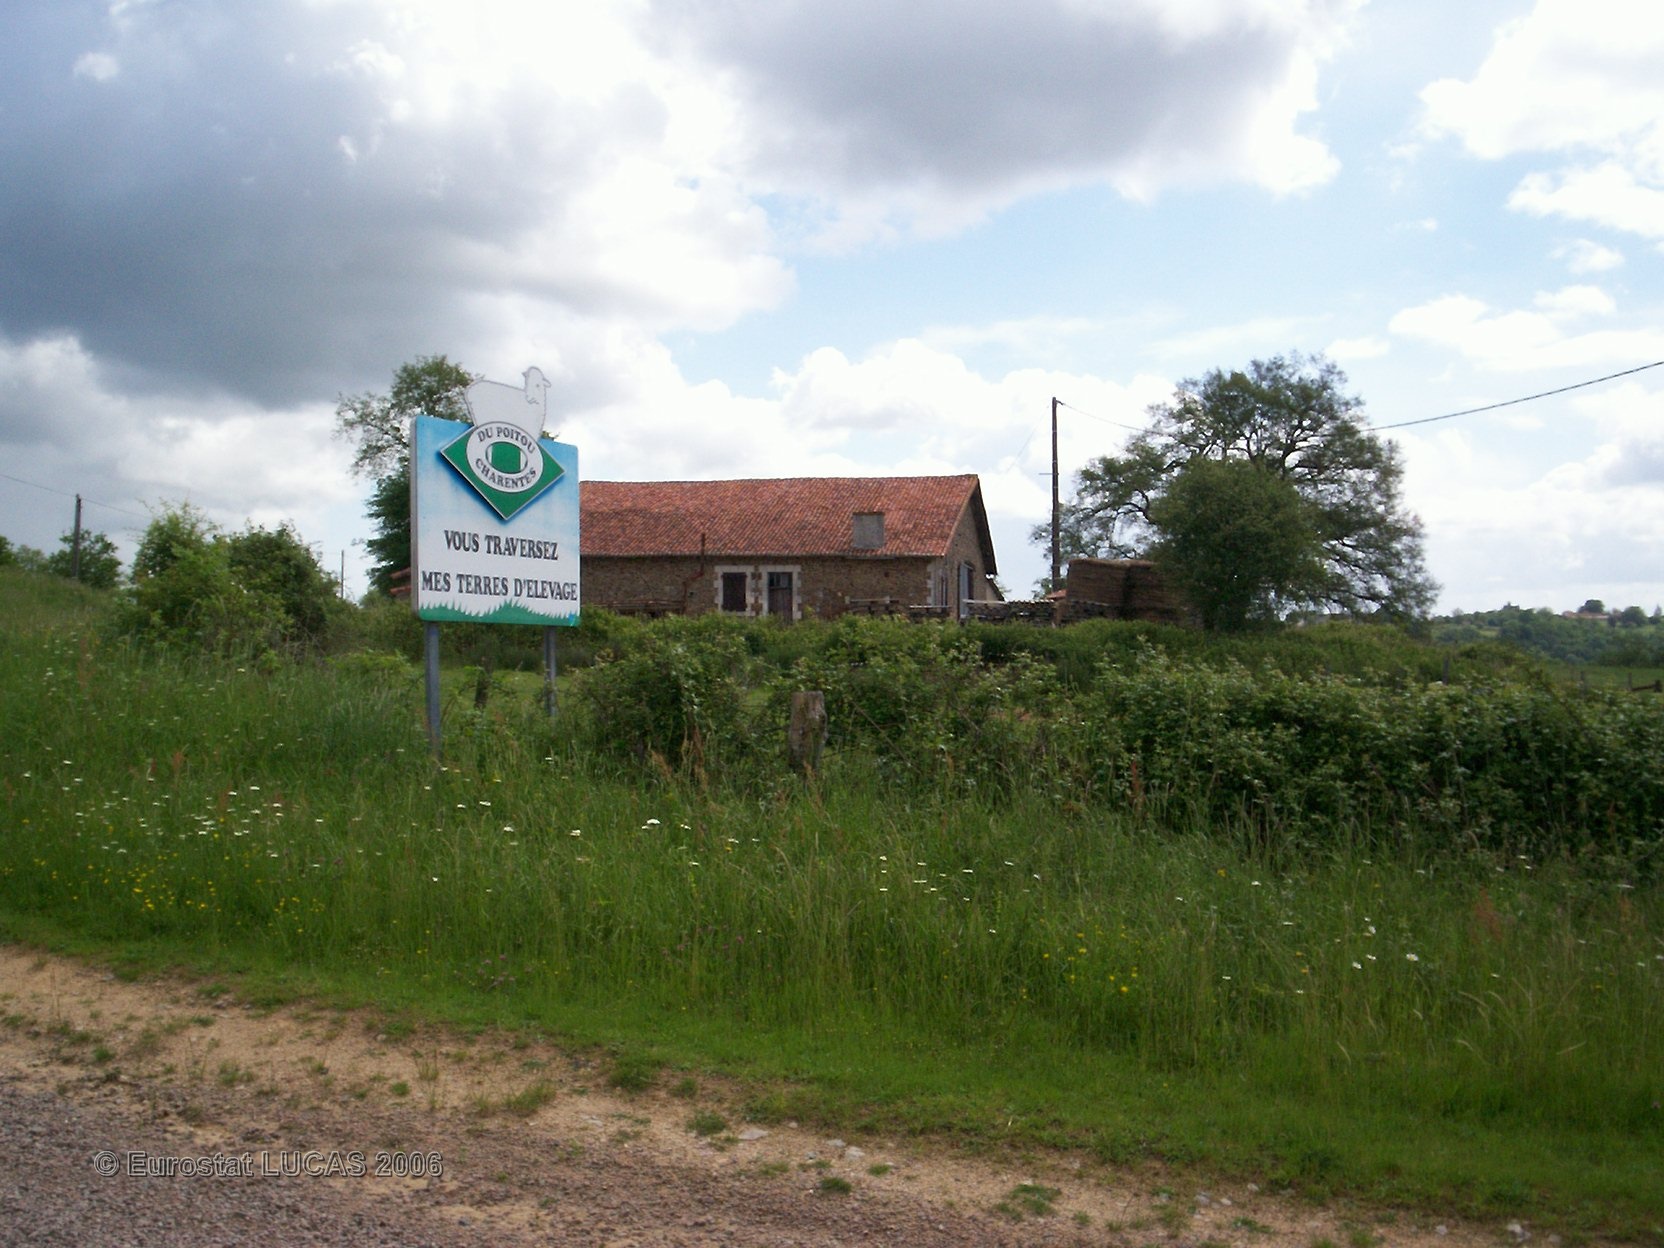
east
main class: Grassland
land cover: Grassland with sparse tree/shrub cover
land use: Unused
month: May
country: FR
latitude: 46.0512
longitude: 0.6673
